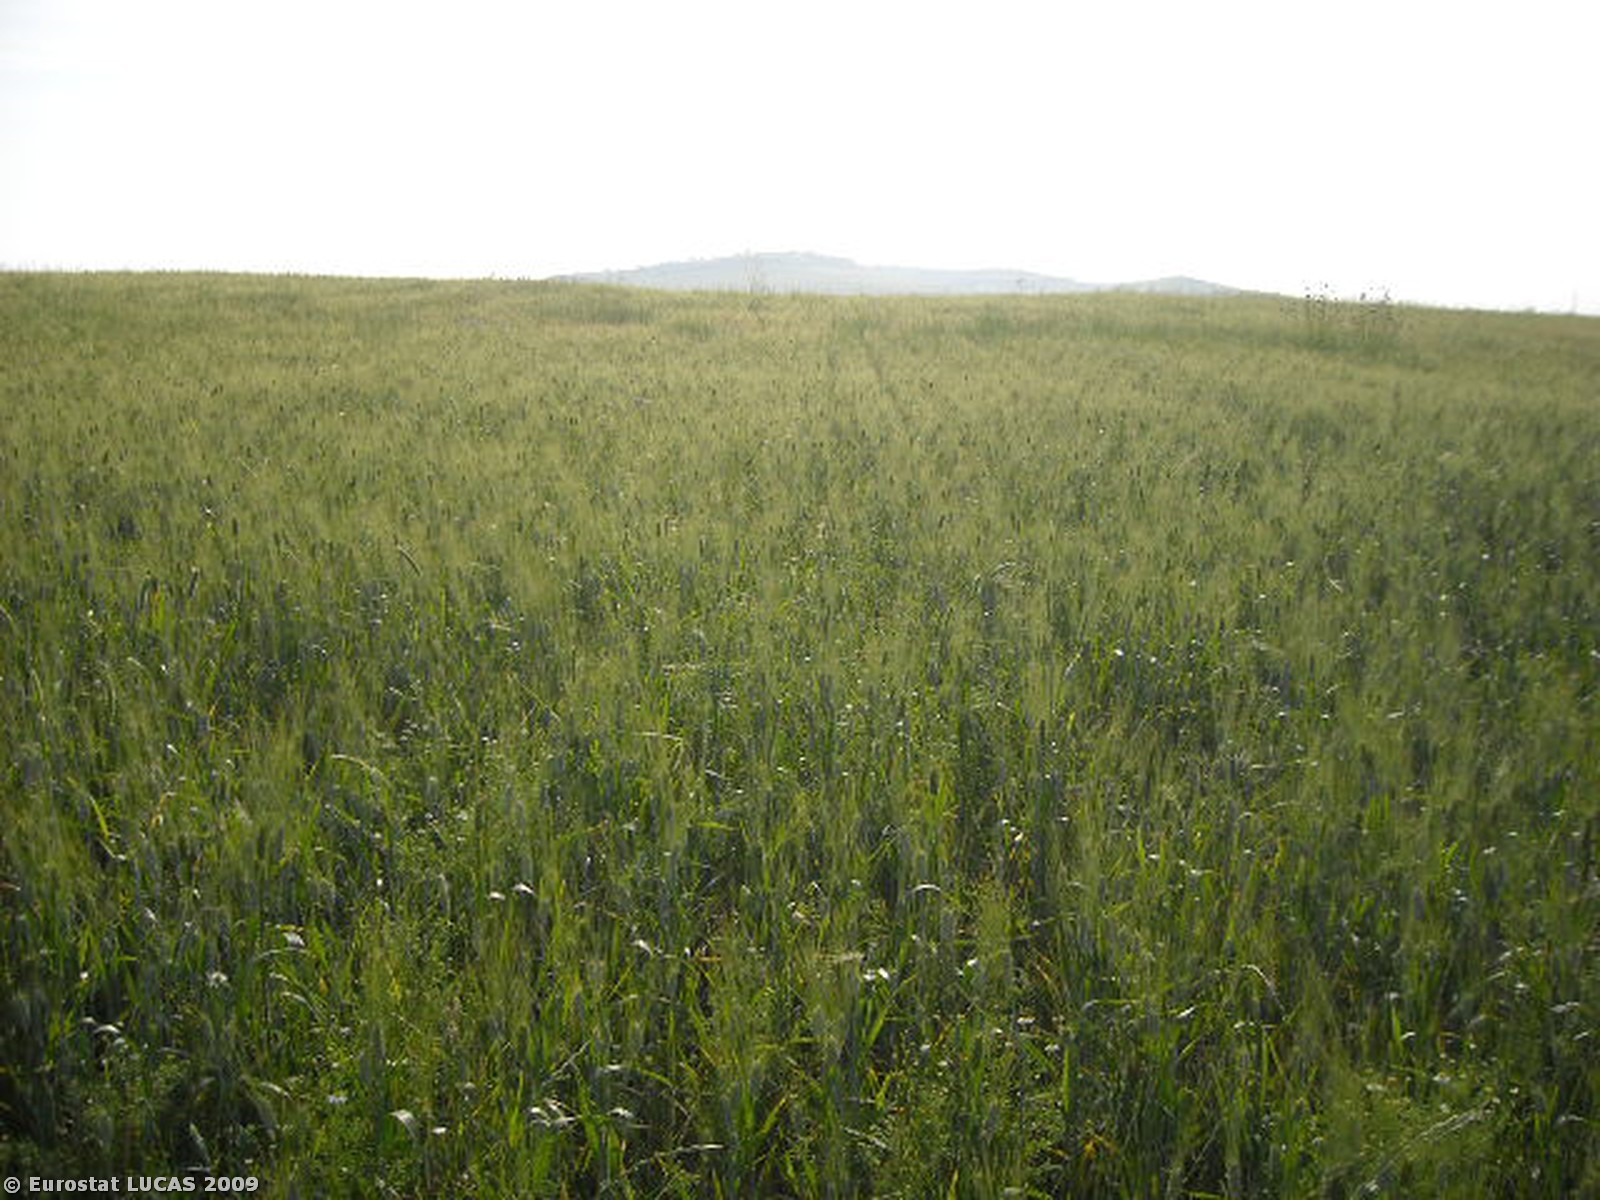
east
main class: Cropland
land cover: Durum wheat
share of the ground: > 75 %
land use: Agriculture (excluding fallow land and kitchen gardens)
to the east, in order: Durum wheat
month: May
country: IT
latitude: 40.6988
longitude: 16.5927
